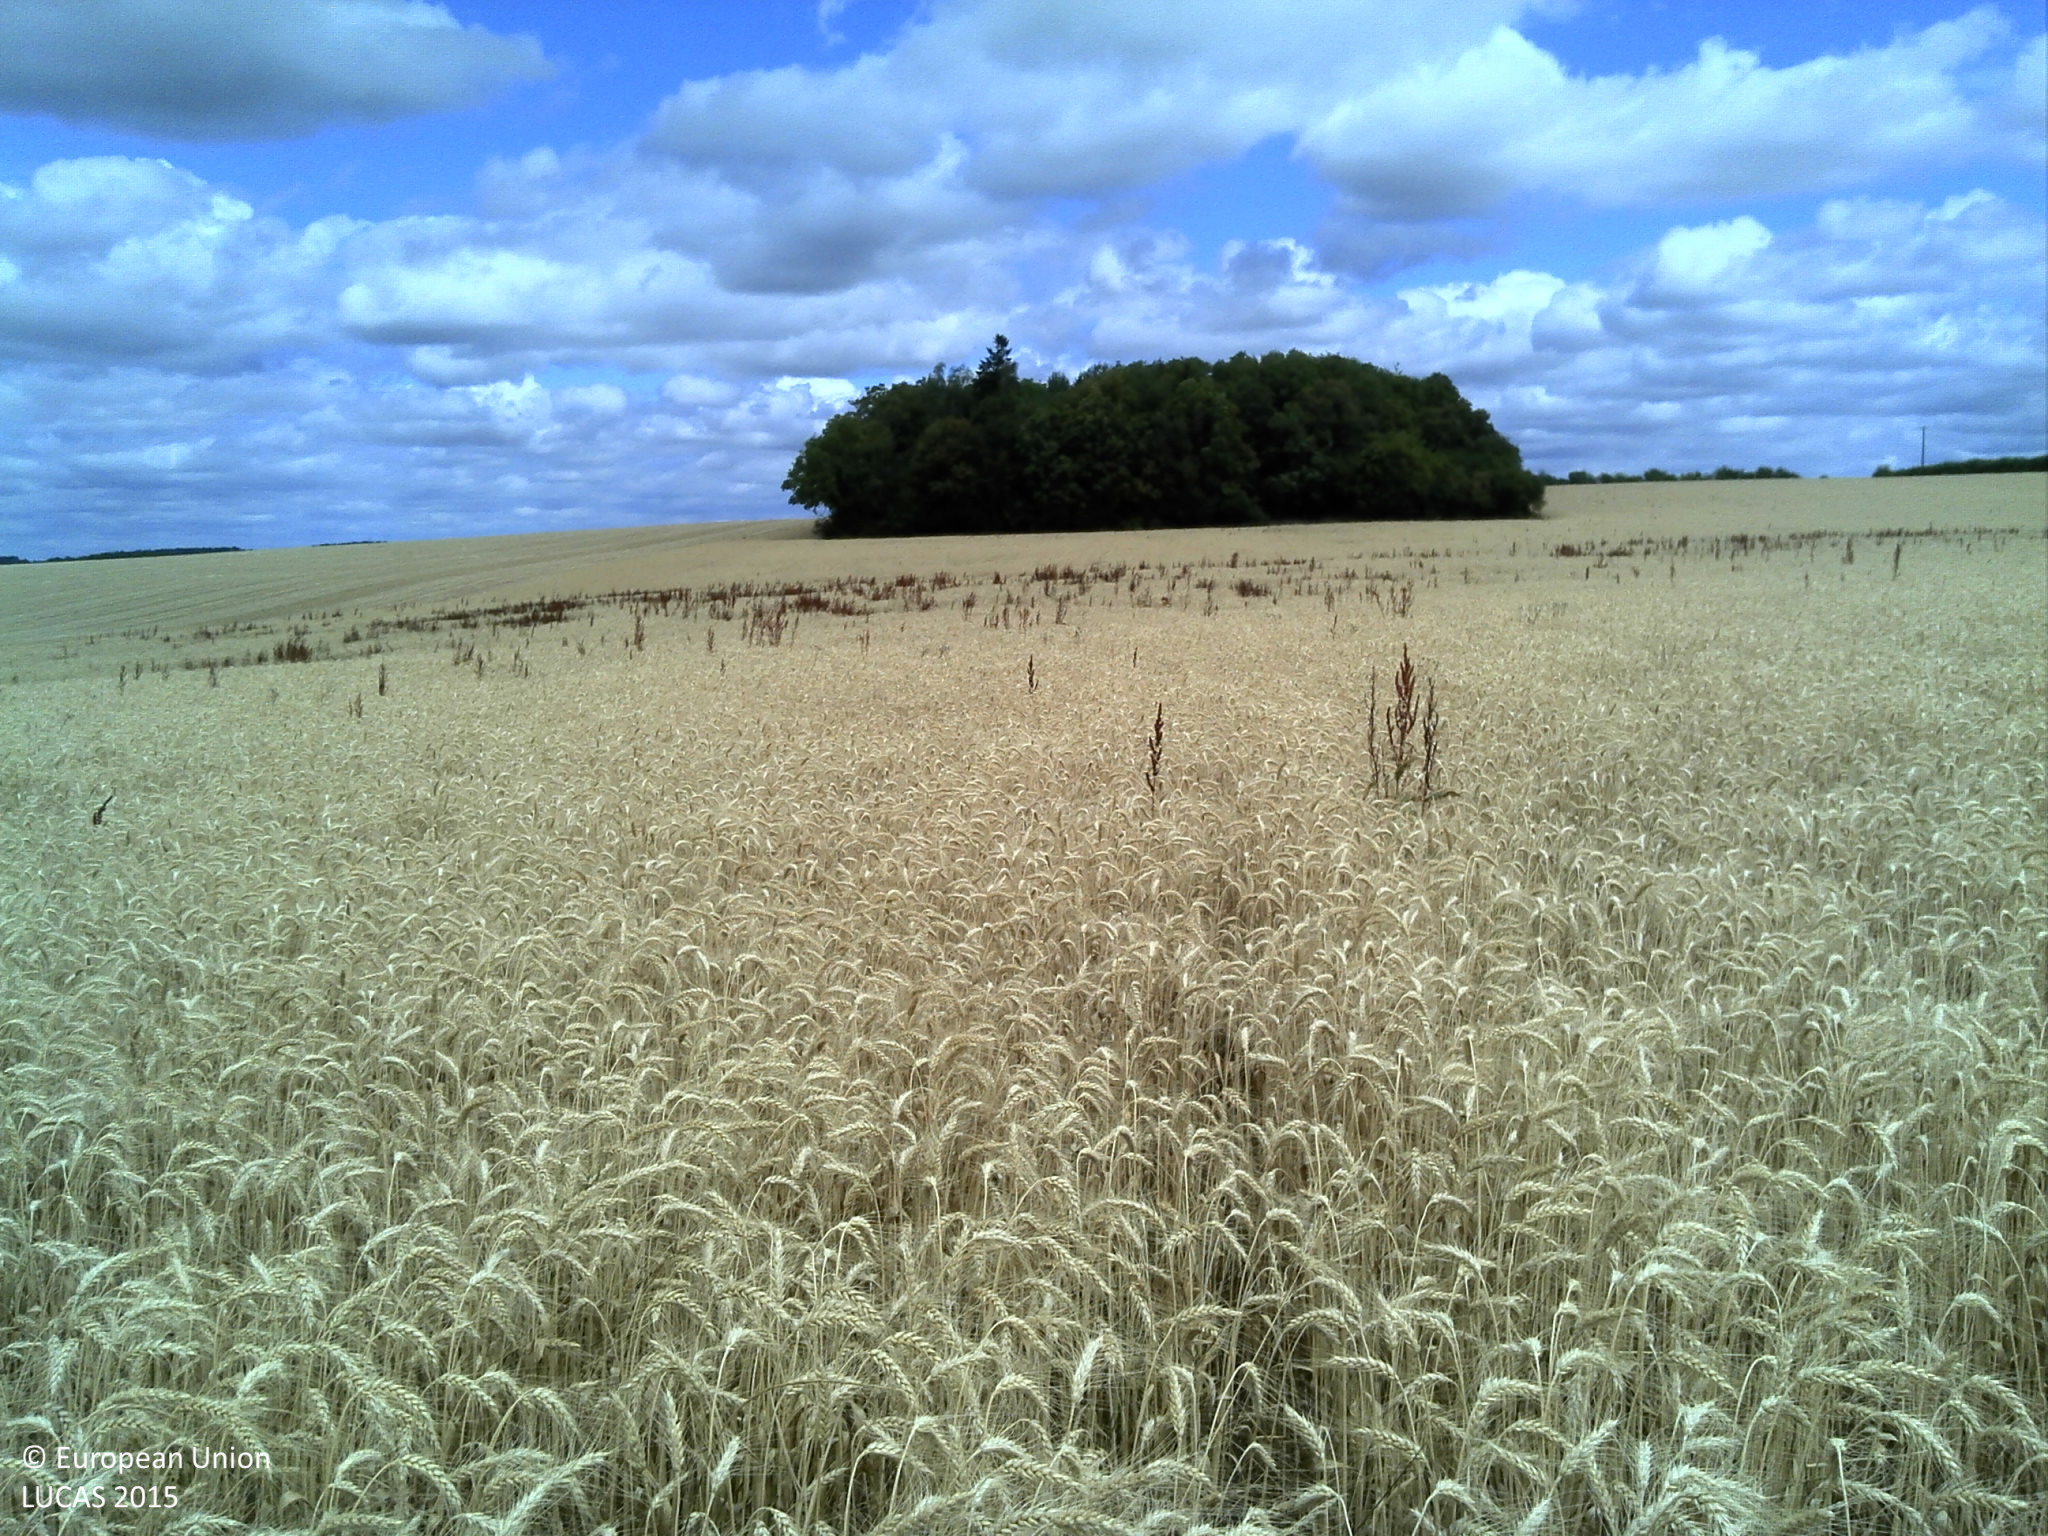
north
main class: Cropland
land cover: Durum wheat
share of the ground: > 75 %
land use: Agriculture (excluding fallow land and kitchen gardens)
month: July
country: FR
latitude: 48.1693
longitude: 6.0068
